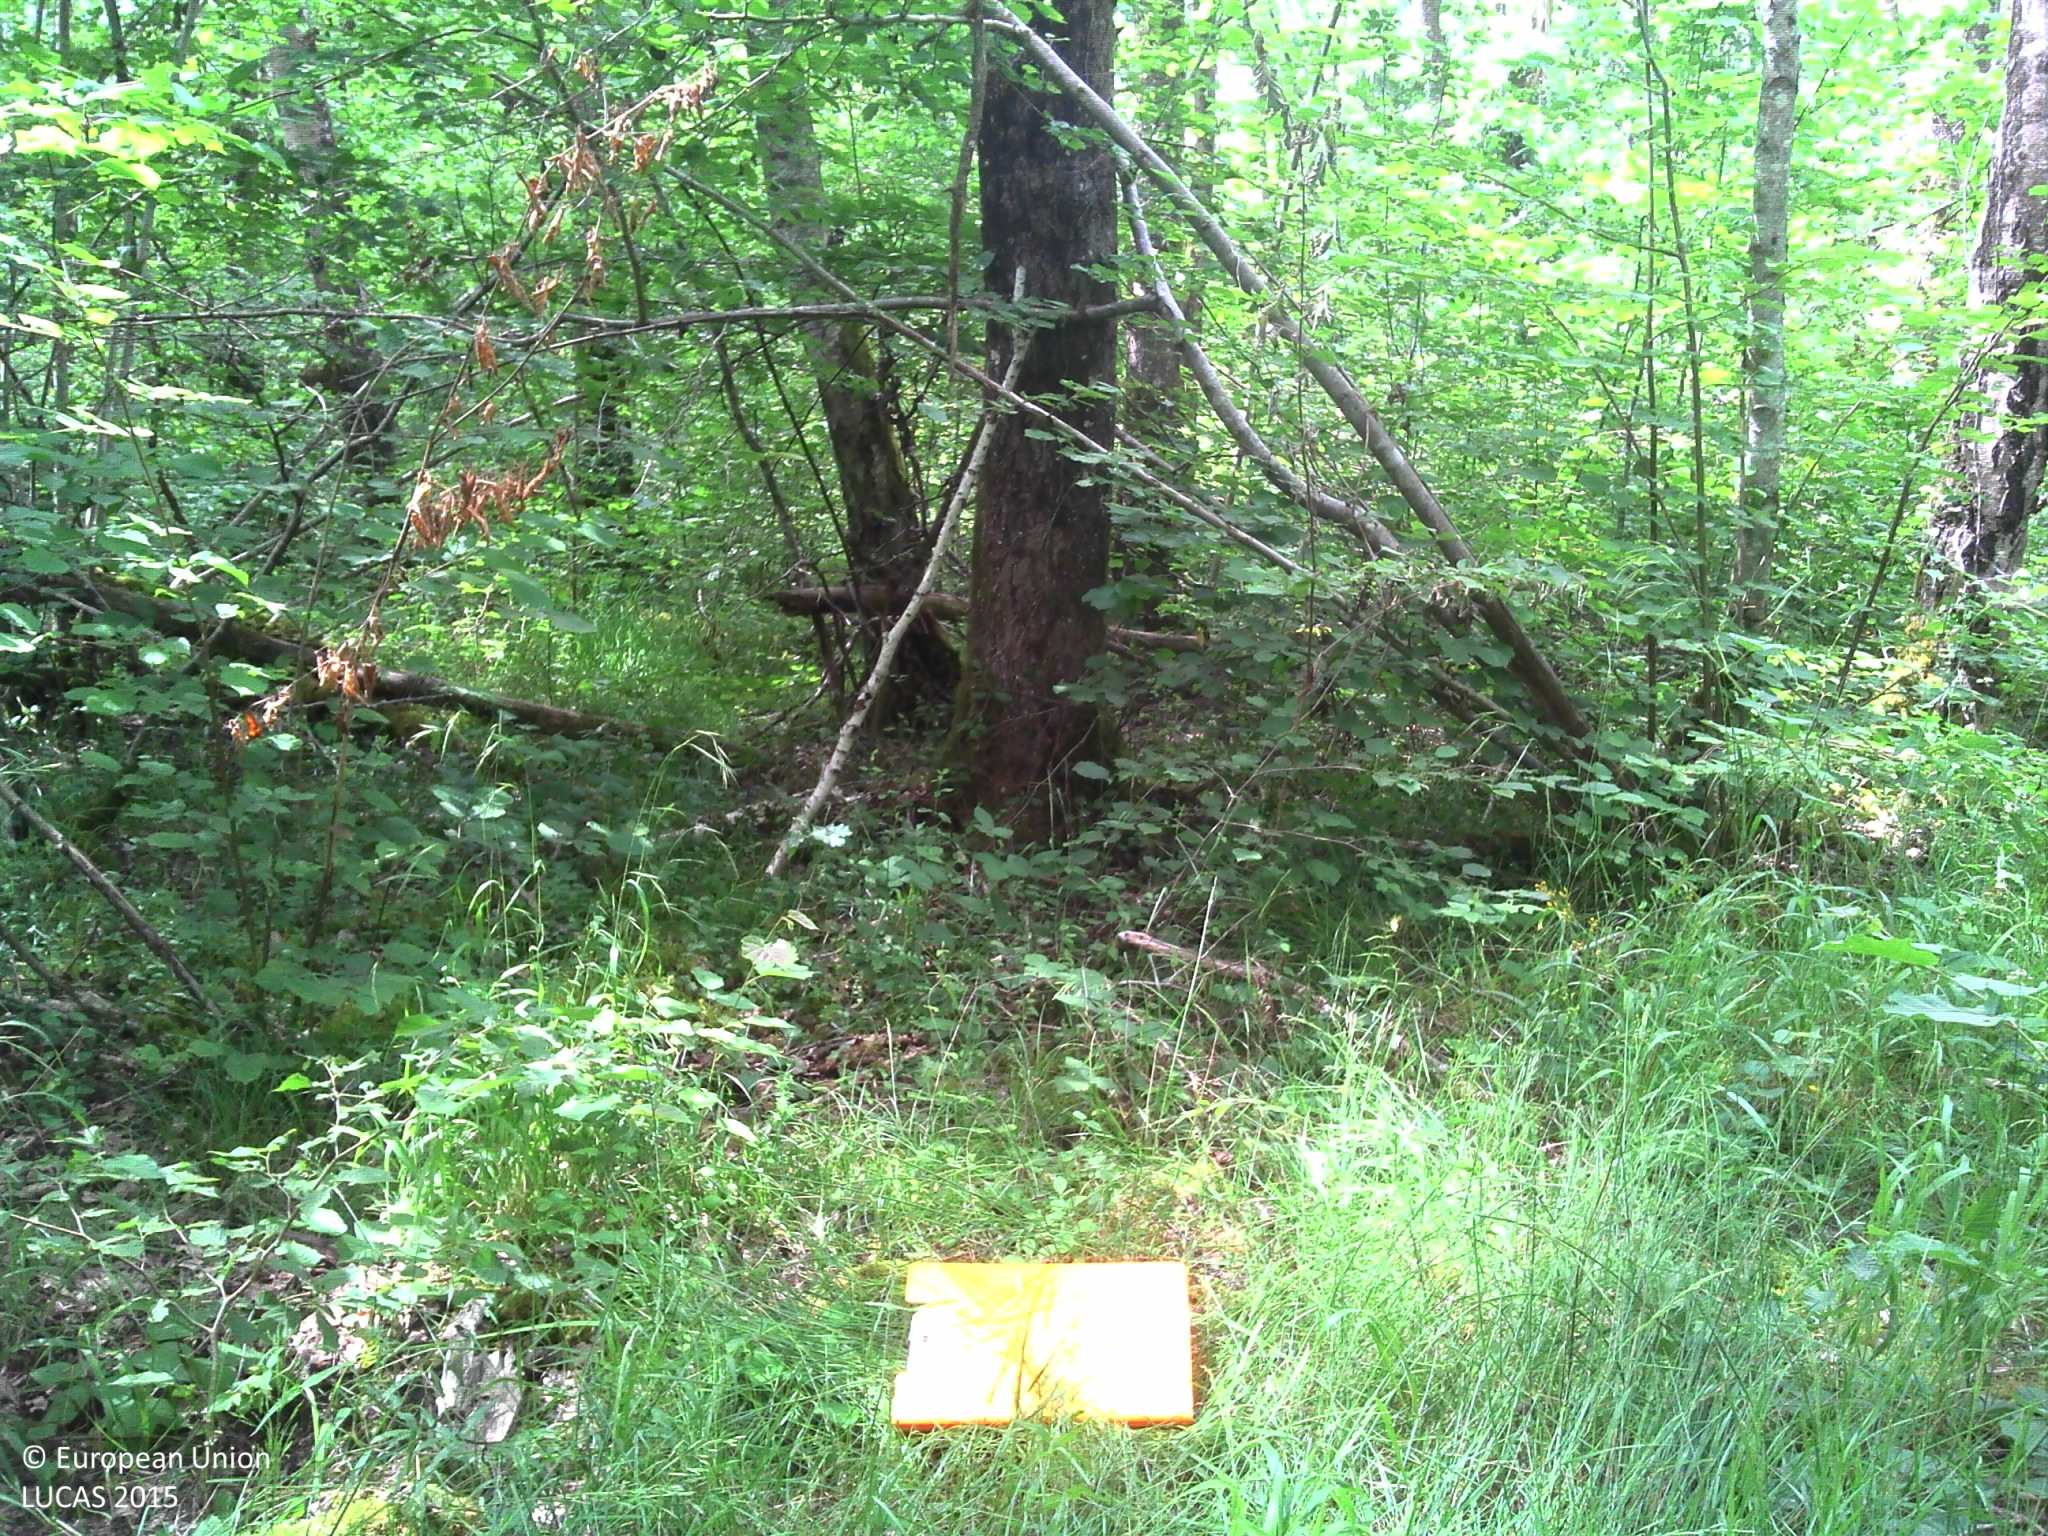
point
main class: Woodland
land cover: Broadleaved woodland
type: mesophytic deciduous forest
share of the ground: > 75 %
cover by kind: broadleaved forest trees 95 %, herbaceous plants 5 %
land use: Forestry
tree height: > 5 m
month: June
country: FR
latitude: 47.1139
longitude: 2.9707
